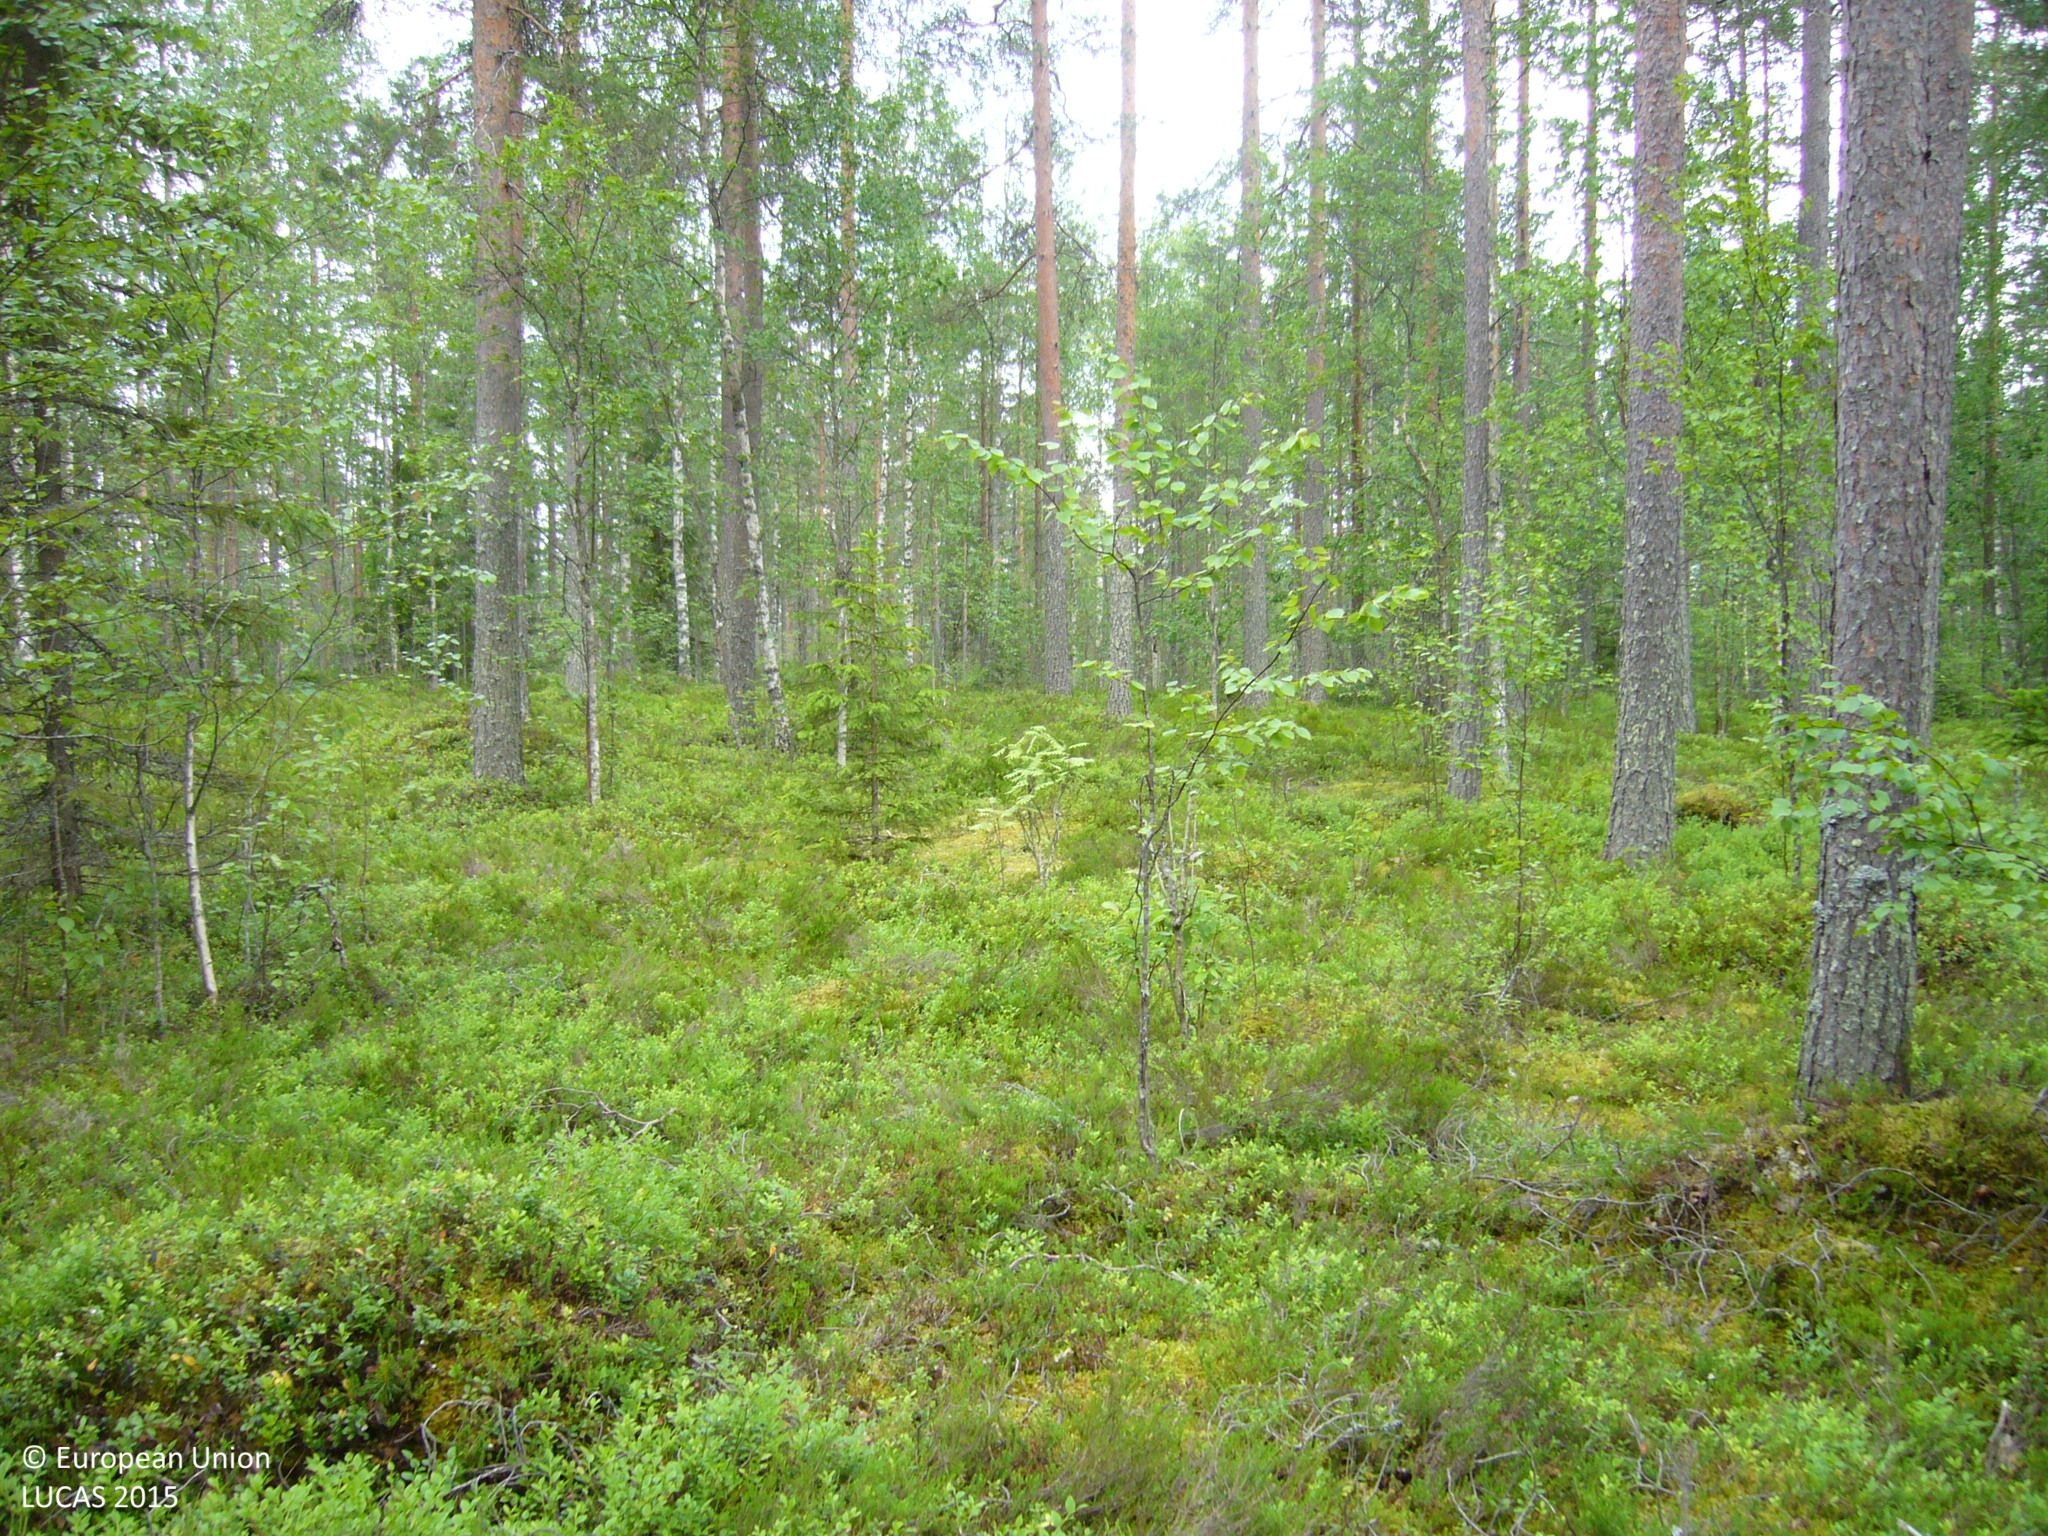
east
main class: Woodland
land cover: Pine dominated mixed woodland
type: boreal forest
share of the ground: 50 - 75 %
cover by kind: coniferous forest trees 40 %, shrubs 35 %, broadleaved forest trees 25 %
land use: Forestry
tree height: > 5 m
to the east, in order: Pine dominated mixed woodland; Tracks; Pine dominated mixed woodland; Pine dominated coniferous woodland; Pine dominated mixed woodland; Ditches and canals; Pine dominated mixed woodland; Ditches and canals; Pine dominated mixed woodland
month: July
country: FI
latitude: 63.6976
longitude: 25.7409
